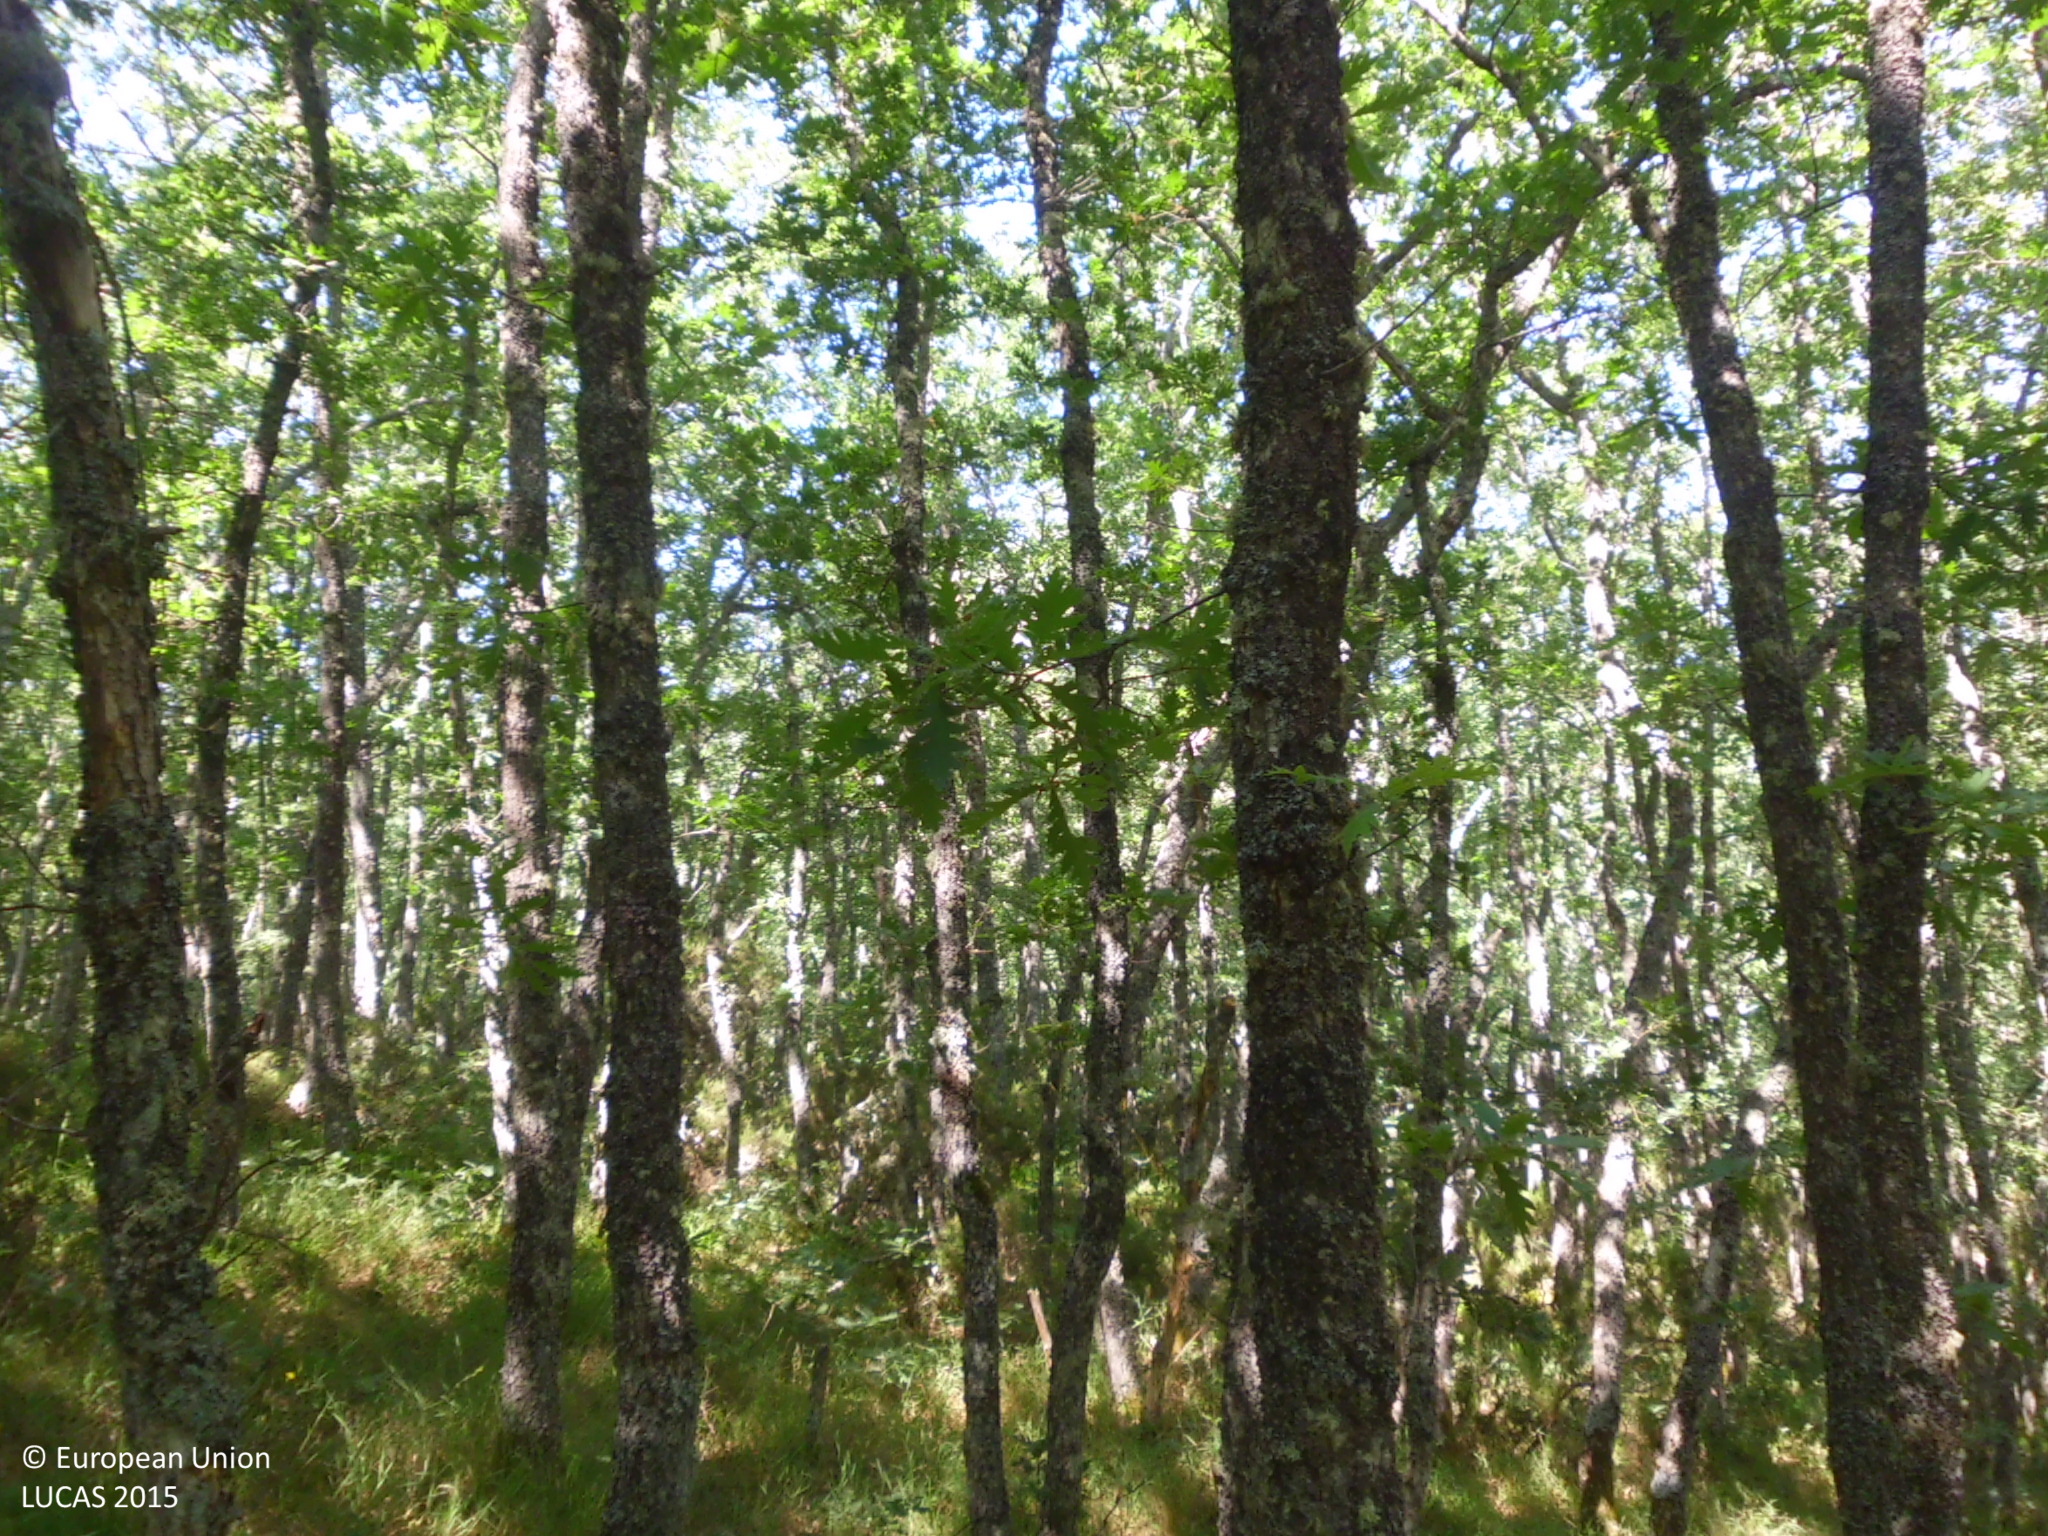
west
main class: Woodland
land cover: Broadleaved woodland
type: acidophilous oak and oak-birch forest
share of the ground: > 75 %
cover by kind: broadleaved forest trees 100 %
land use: Semi-natural and natural areas not in use
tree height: > 5 m
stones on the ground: 10 - 25 %
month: July
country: ES
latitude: 42.2268
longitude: -3.3207
